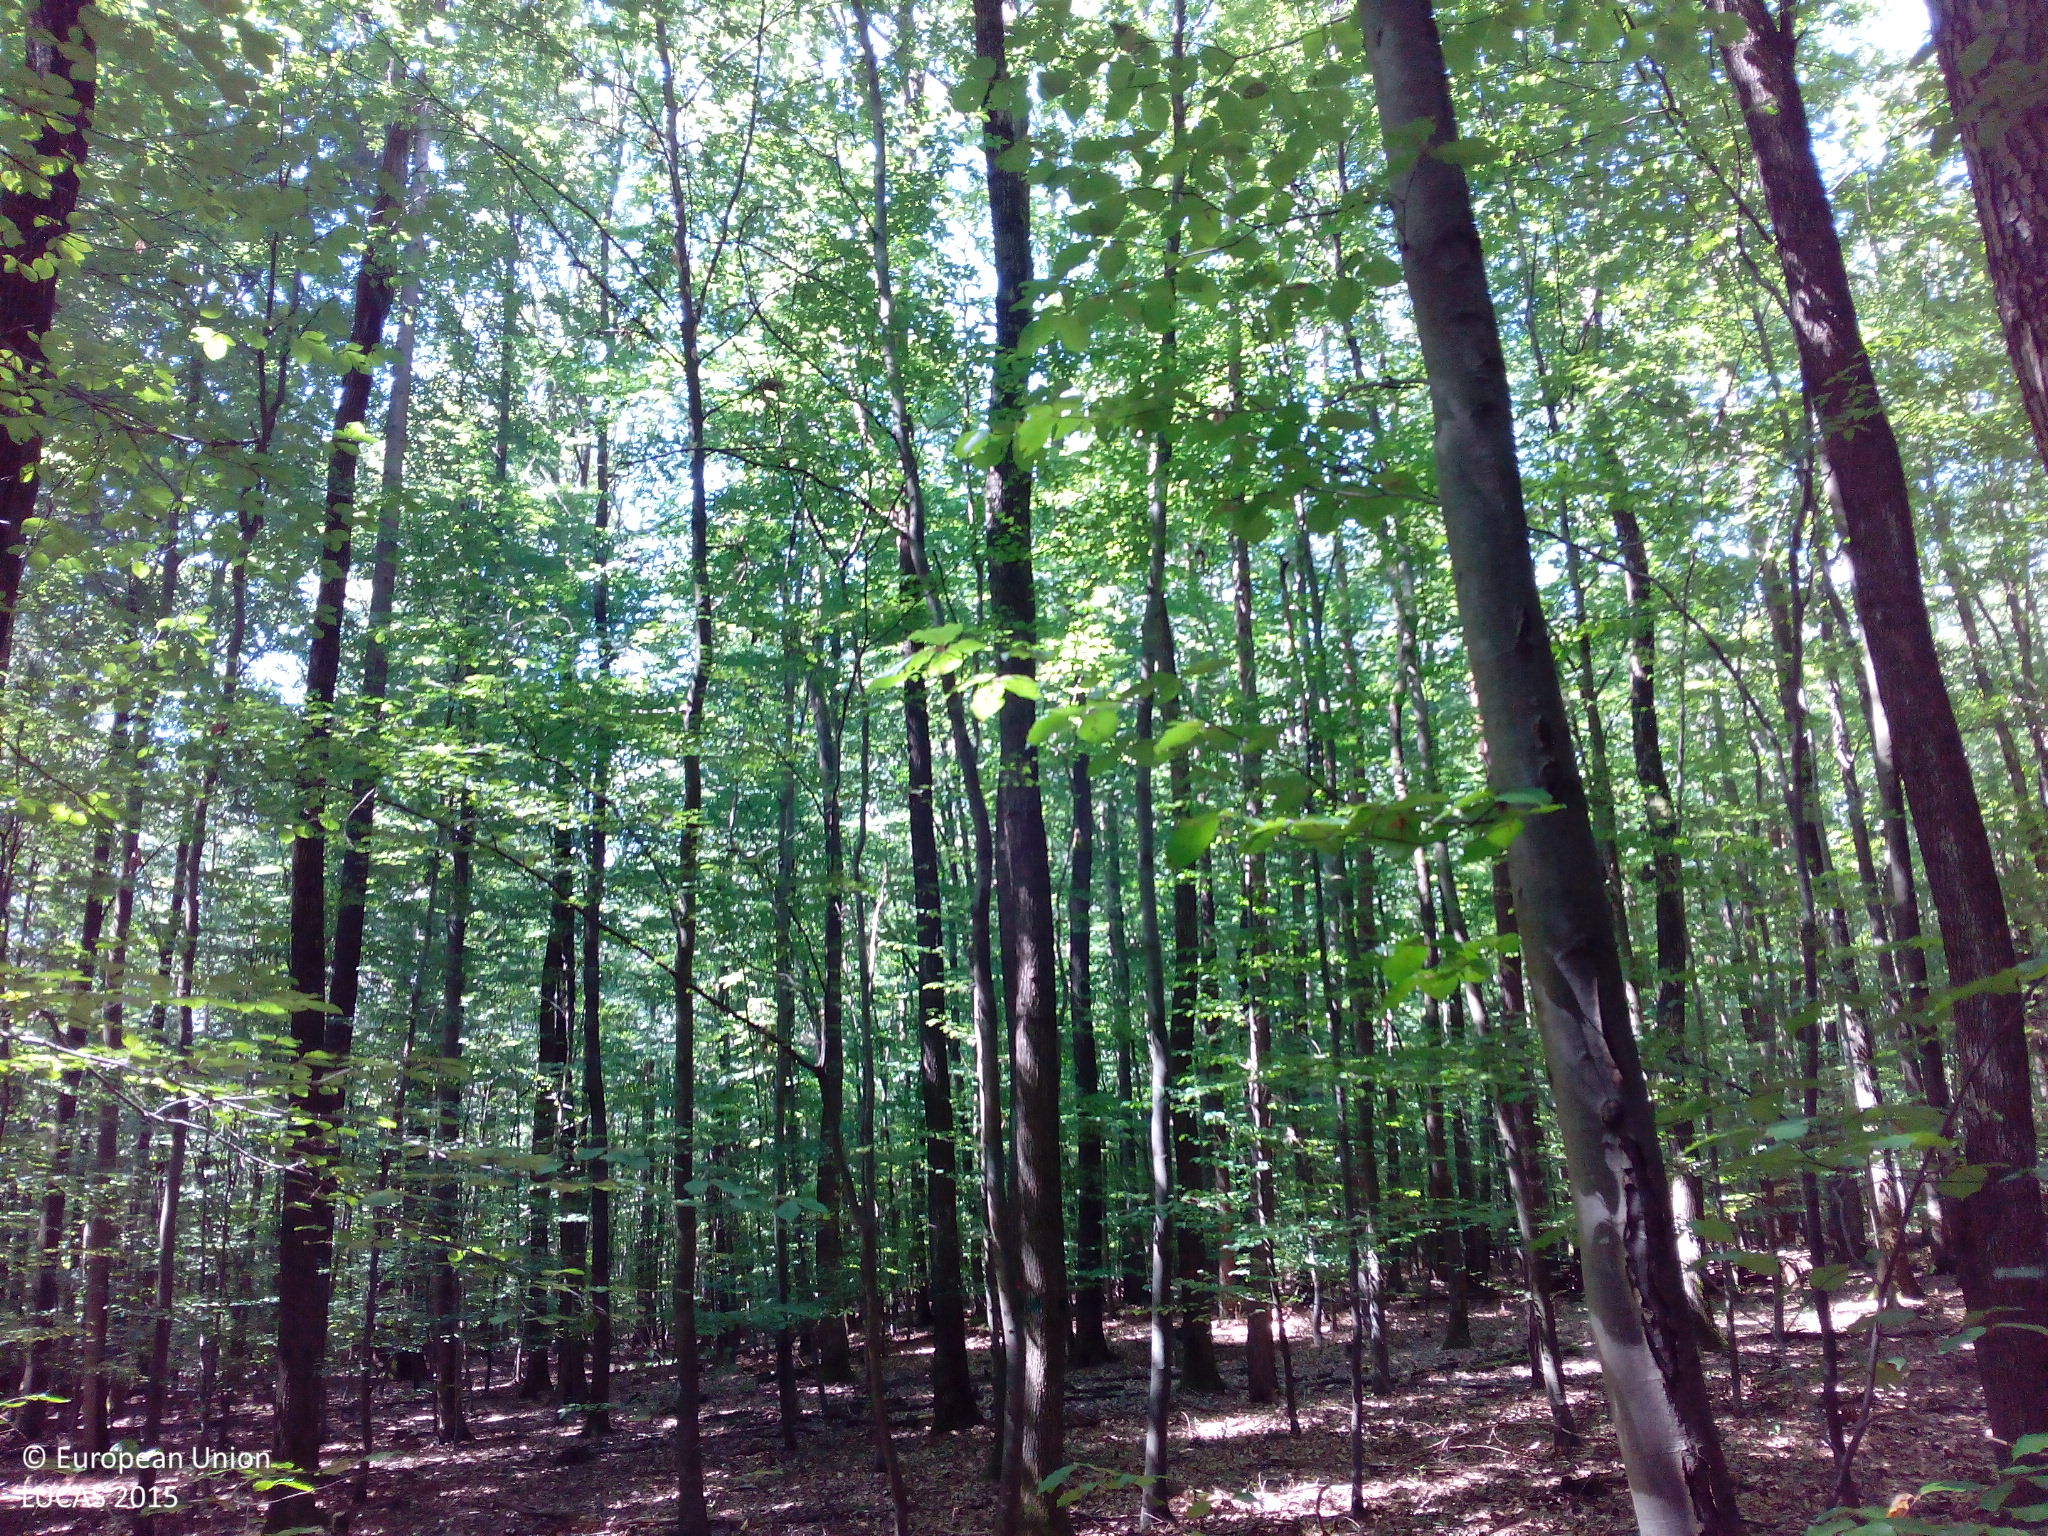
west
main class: Woodland
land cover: Broadleaved woodland
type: beech forest
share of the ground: > 75 %
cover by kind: broadleaved forest trees 80 %, coniferous forest trees 10 %, unconsolidated bare surface 10 %
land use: Forestry
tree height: > 5 m
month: August
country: DE
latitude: 48.9880
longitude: 8.5657
